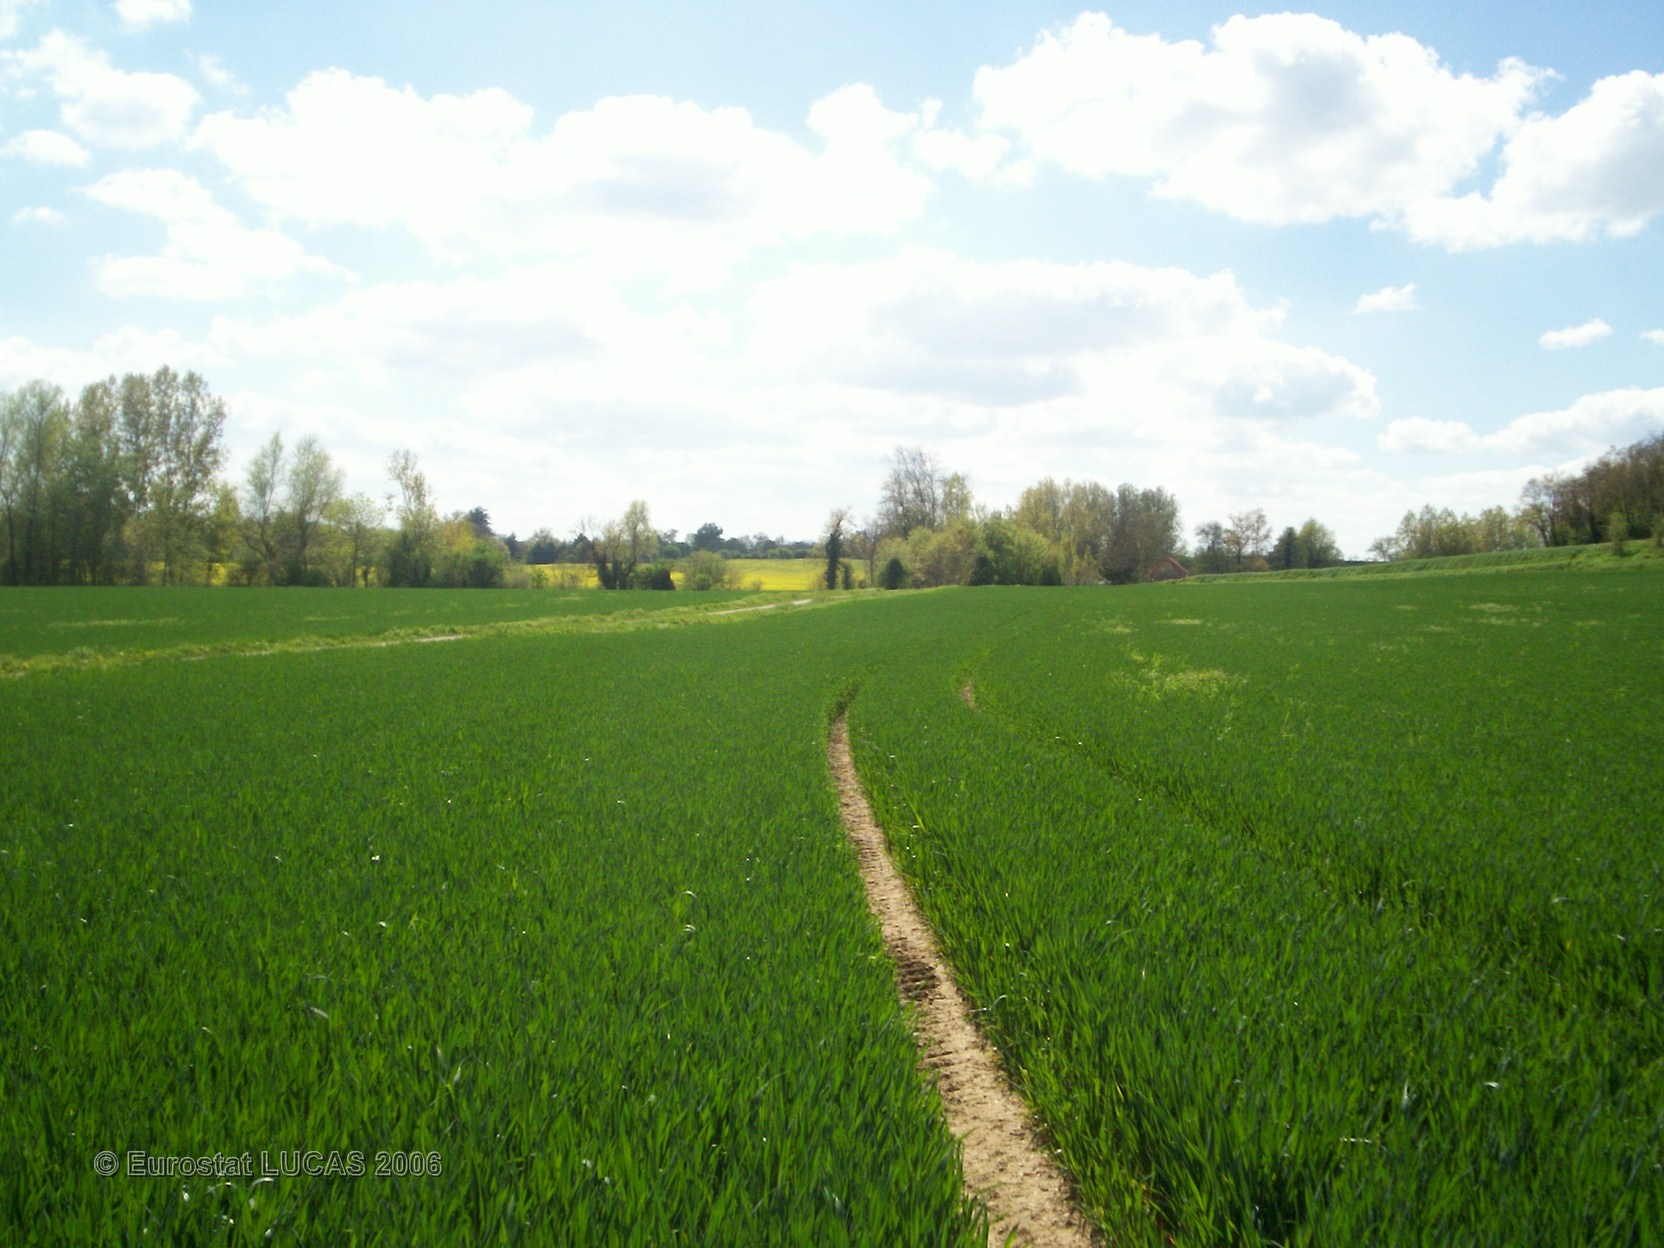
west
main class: Cropland
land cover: Common wheat
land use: Agriculture (excluding fallow land and kitchen gardens)
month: April
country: FR
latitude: 46.2621
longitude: 3.2133
